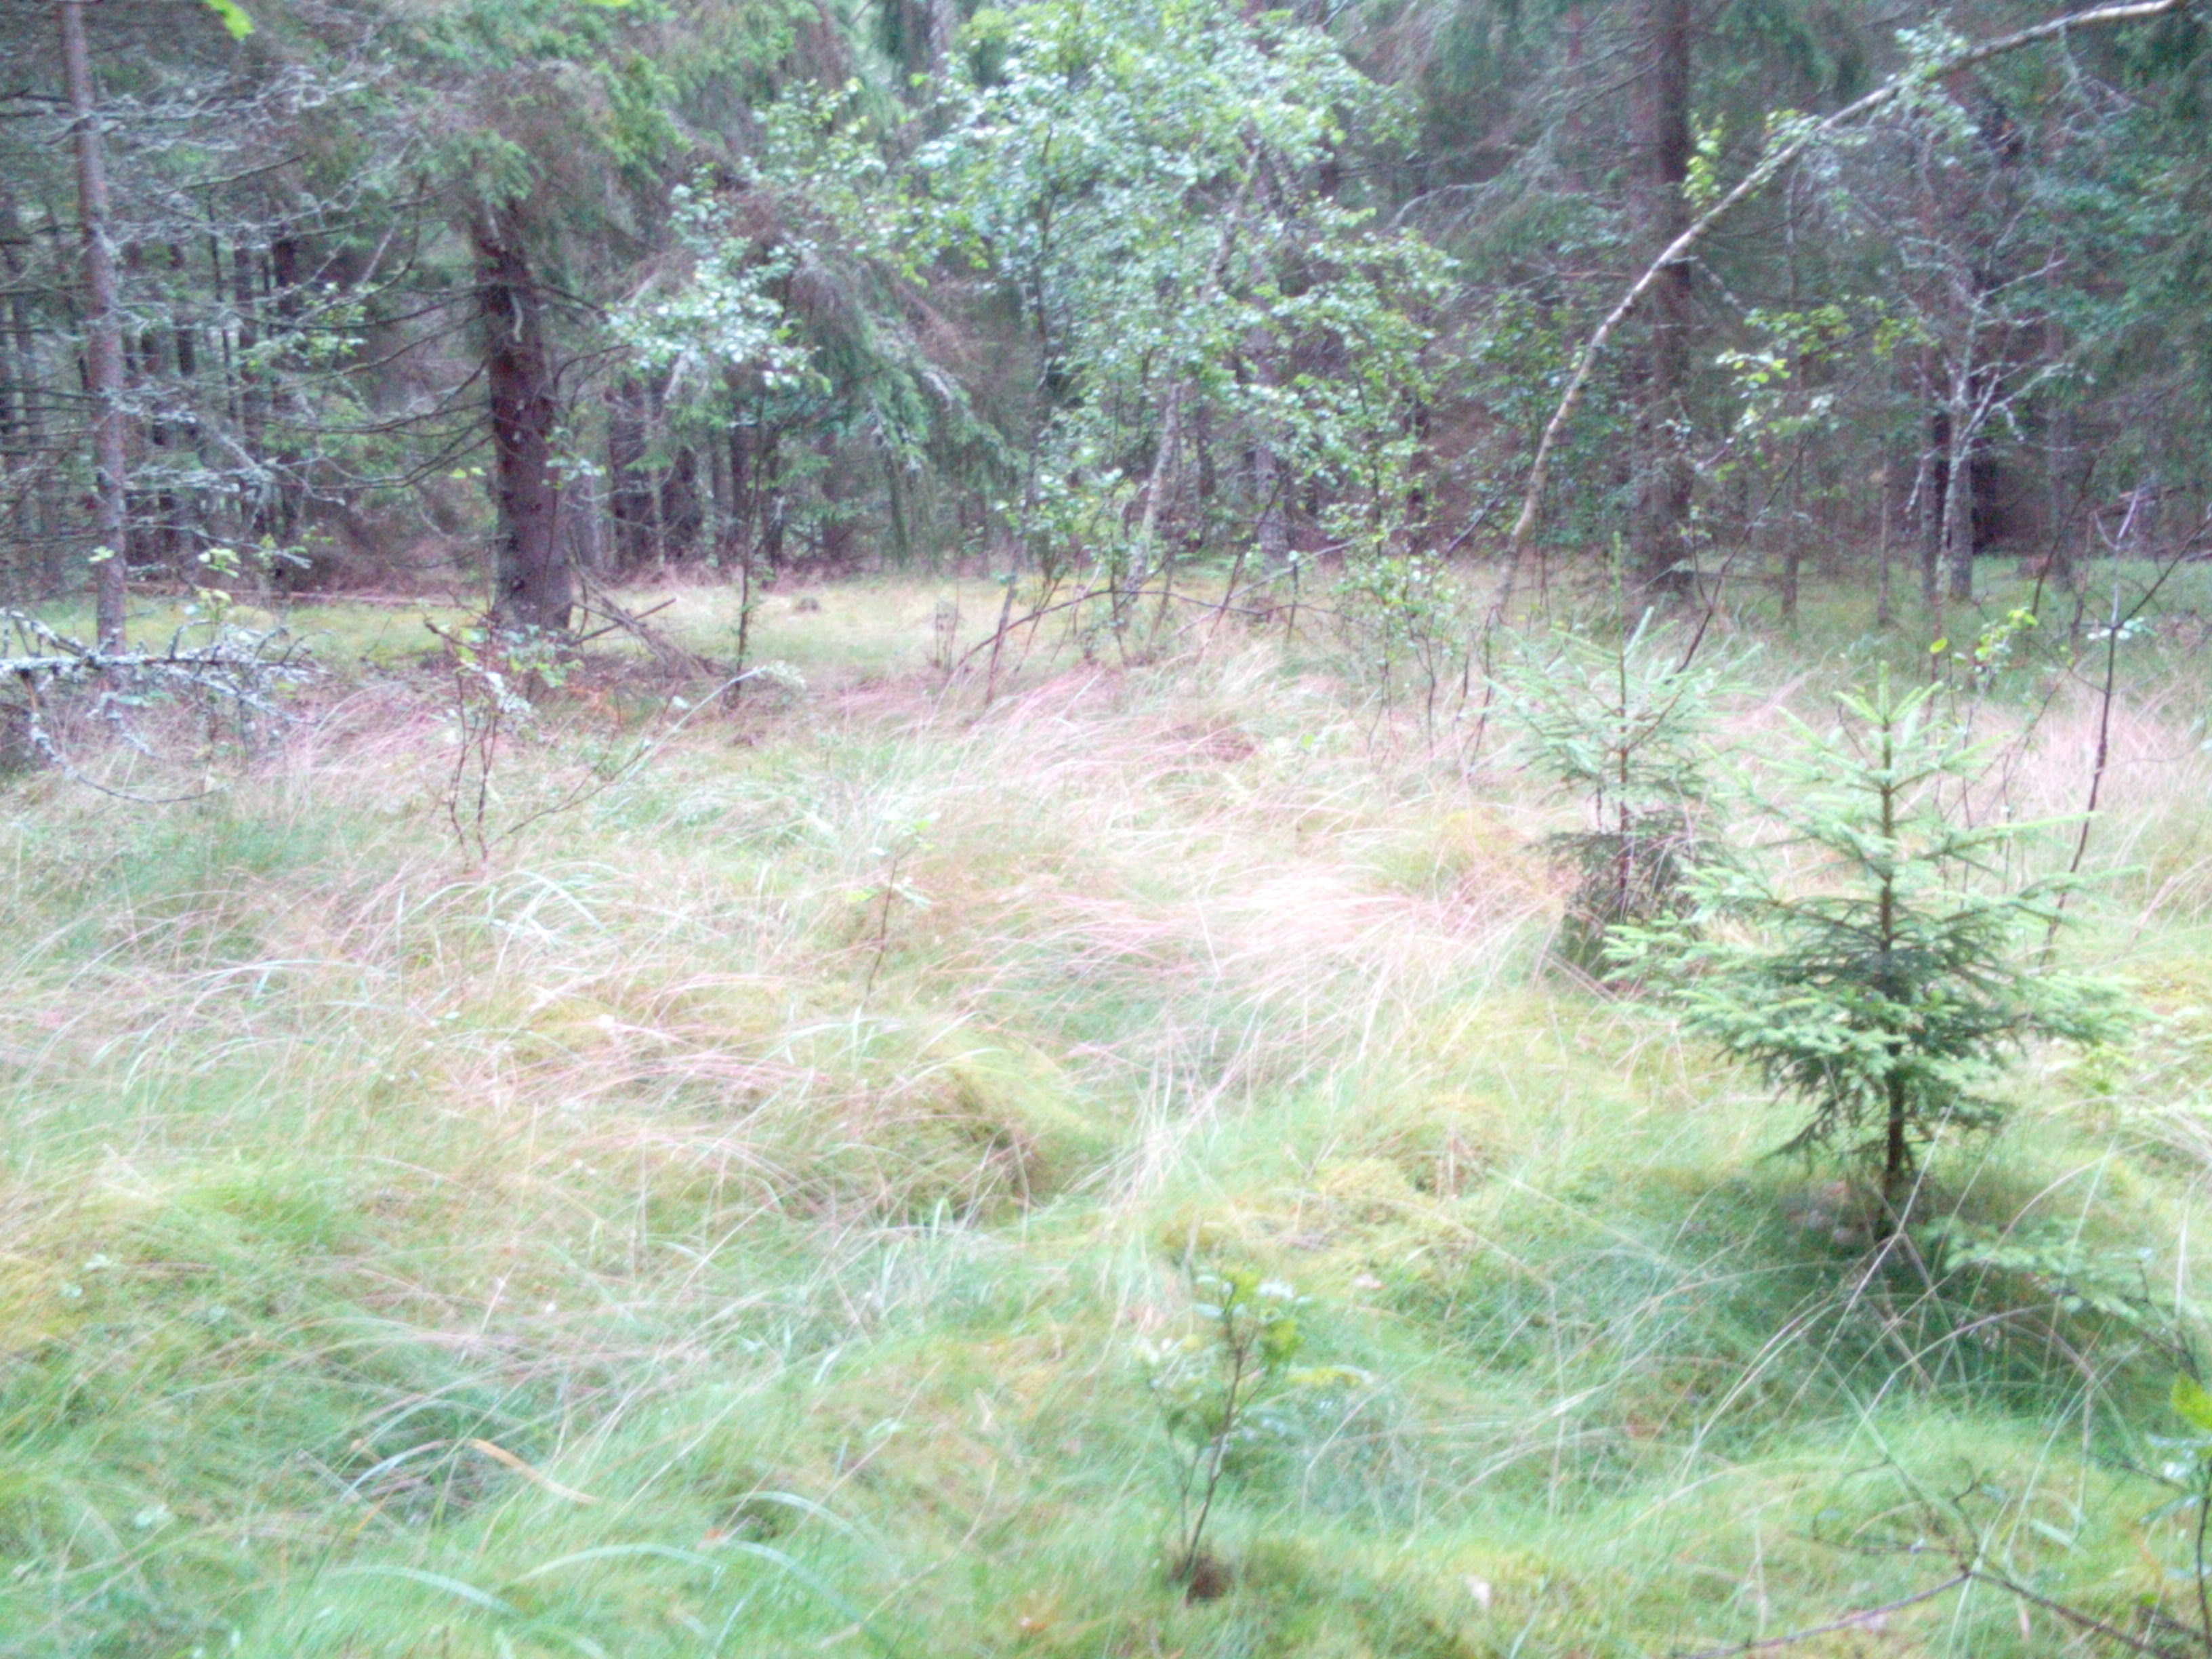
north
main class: Woodland
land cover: Spruce dominated coniferous woodland
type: hemiboreal forest and nemoral coniferous forest and mixed broadleaved-coniferous forest
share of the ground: > 75 %
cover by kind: coniferous forest trees 75 %, herbaceous plants 10 %, lichens and mosses 10 %, broadleaved forest trees 5 %
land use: Forestry
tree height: > 5 m
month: July
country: LV
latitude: 57.0101
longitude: 21.9523
